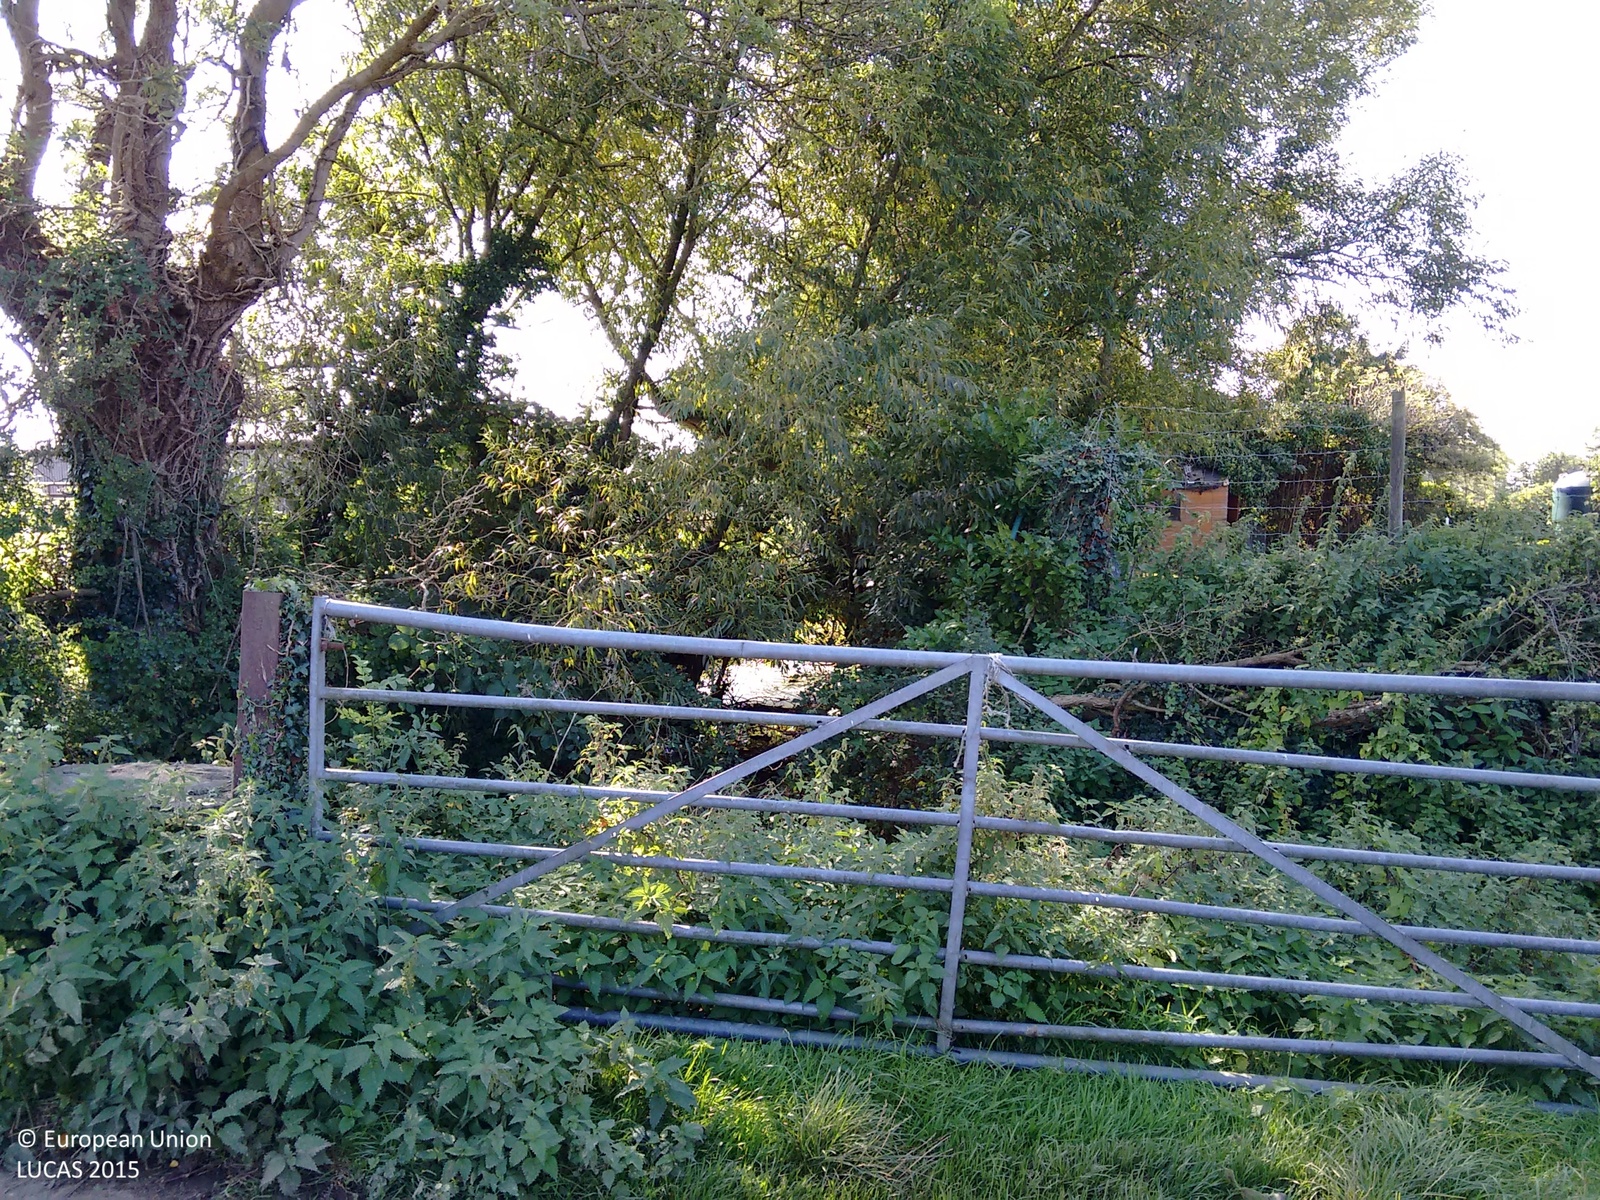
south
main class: Grassland
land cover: Grassland without tree/shrub cover
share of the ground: > 75 %
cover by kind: herbaceous plants 100 %
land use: Agriculture (excluding fallow land and kitchen gardens)
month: September
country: GB
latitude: 51.5745
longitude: -2.6072
